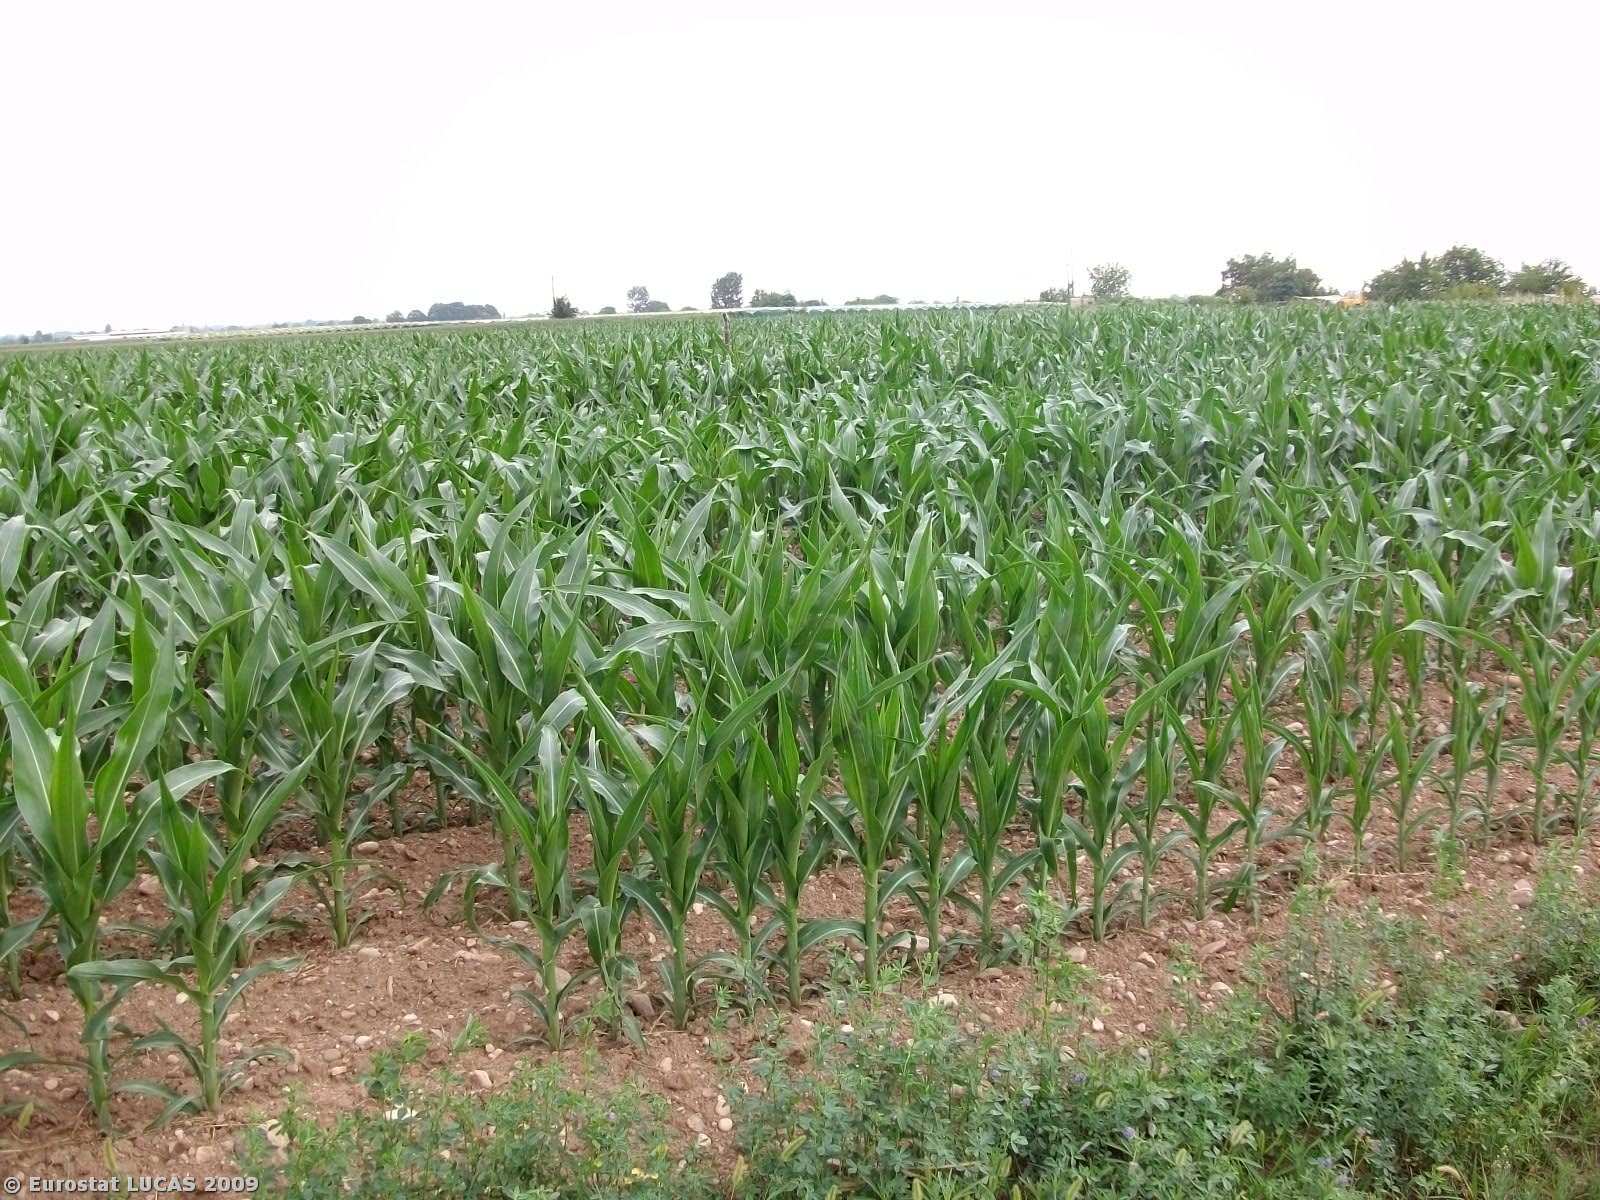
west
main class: Cropland
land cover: Clovers
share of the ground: > 75 %
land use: Agriculture (excluding fallow land and kitchen gardens)
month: July
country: GR
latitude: 39.4927
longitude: 21.6912
